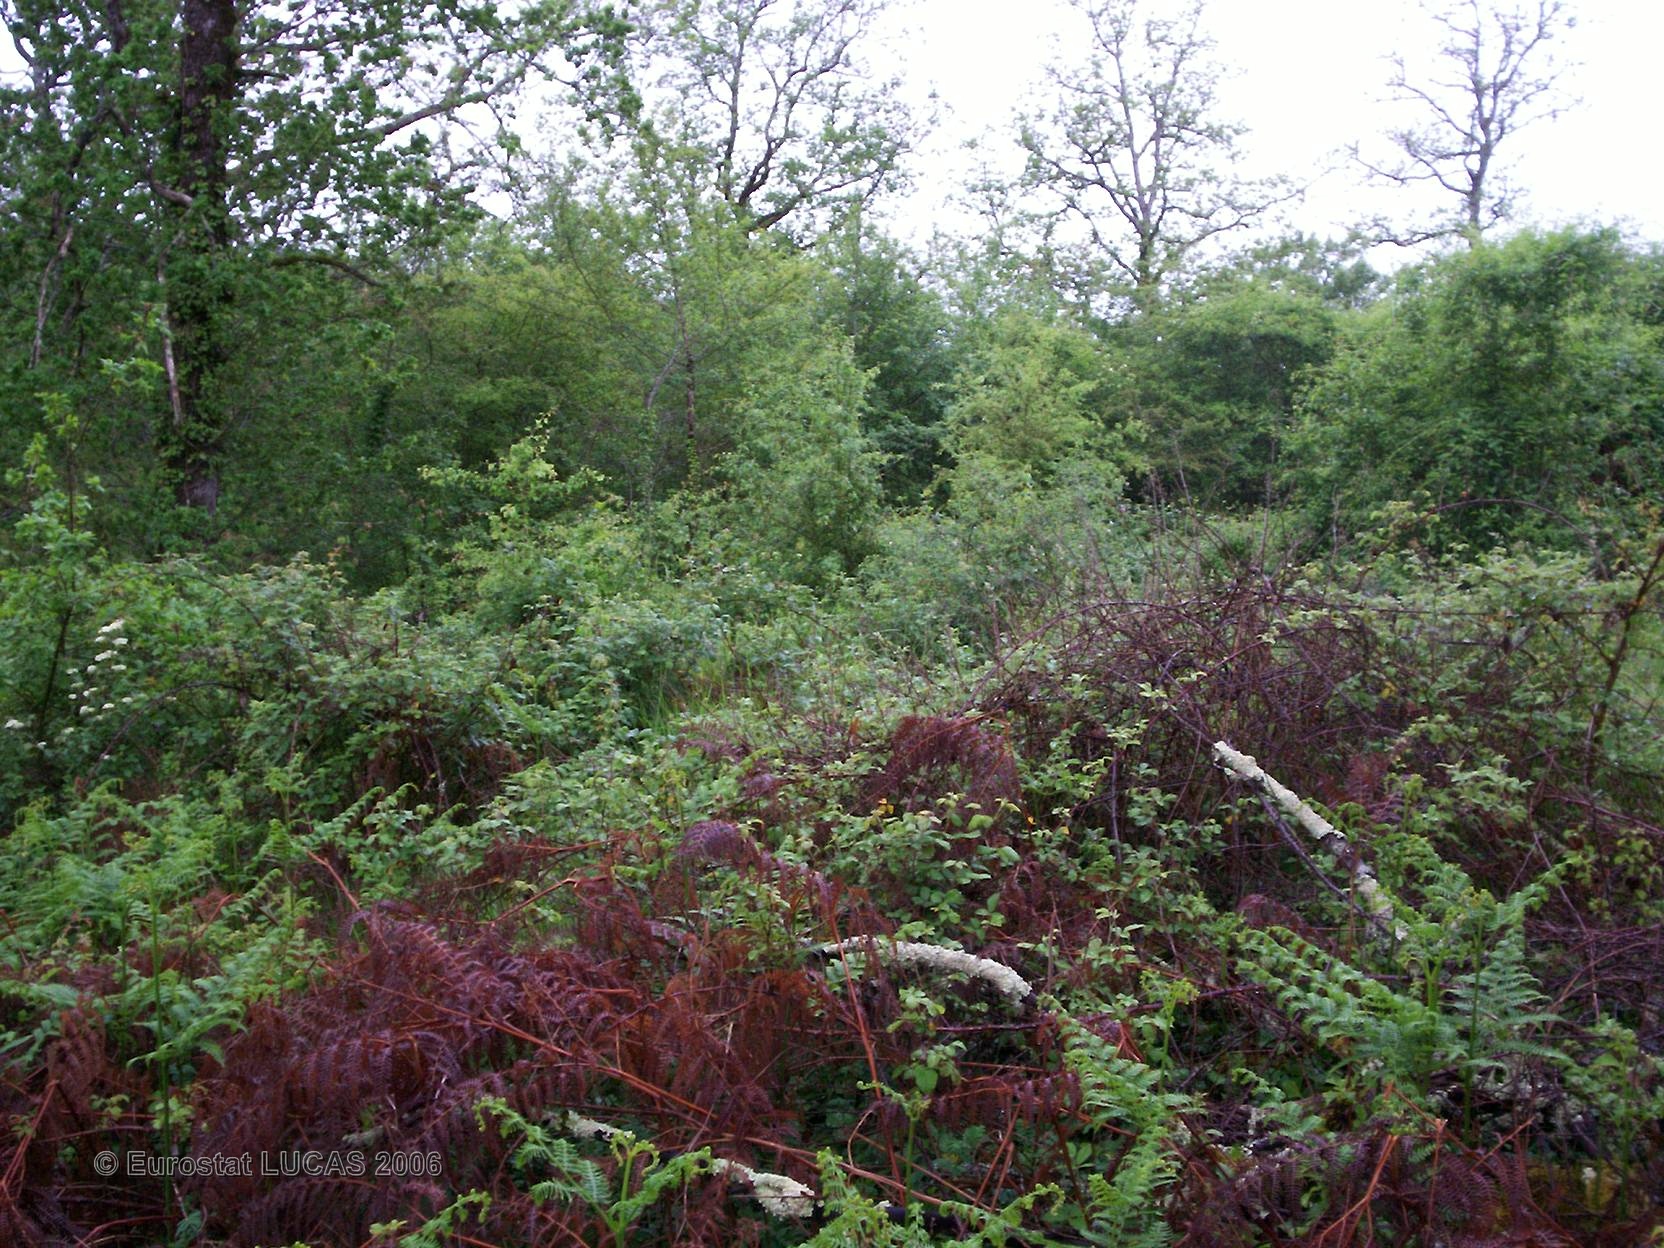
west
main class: Grassland
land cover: Grassland with sparse tree/shrub cover
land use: Agriculture (excluding fallow land and kitchen gardens)
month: May
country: FR
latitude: 45.4058
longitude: 0.5461
